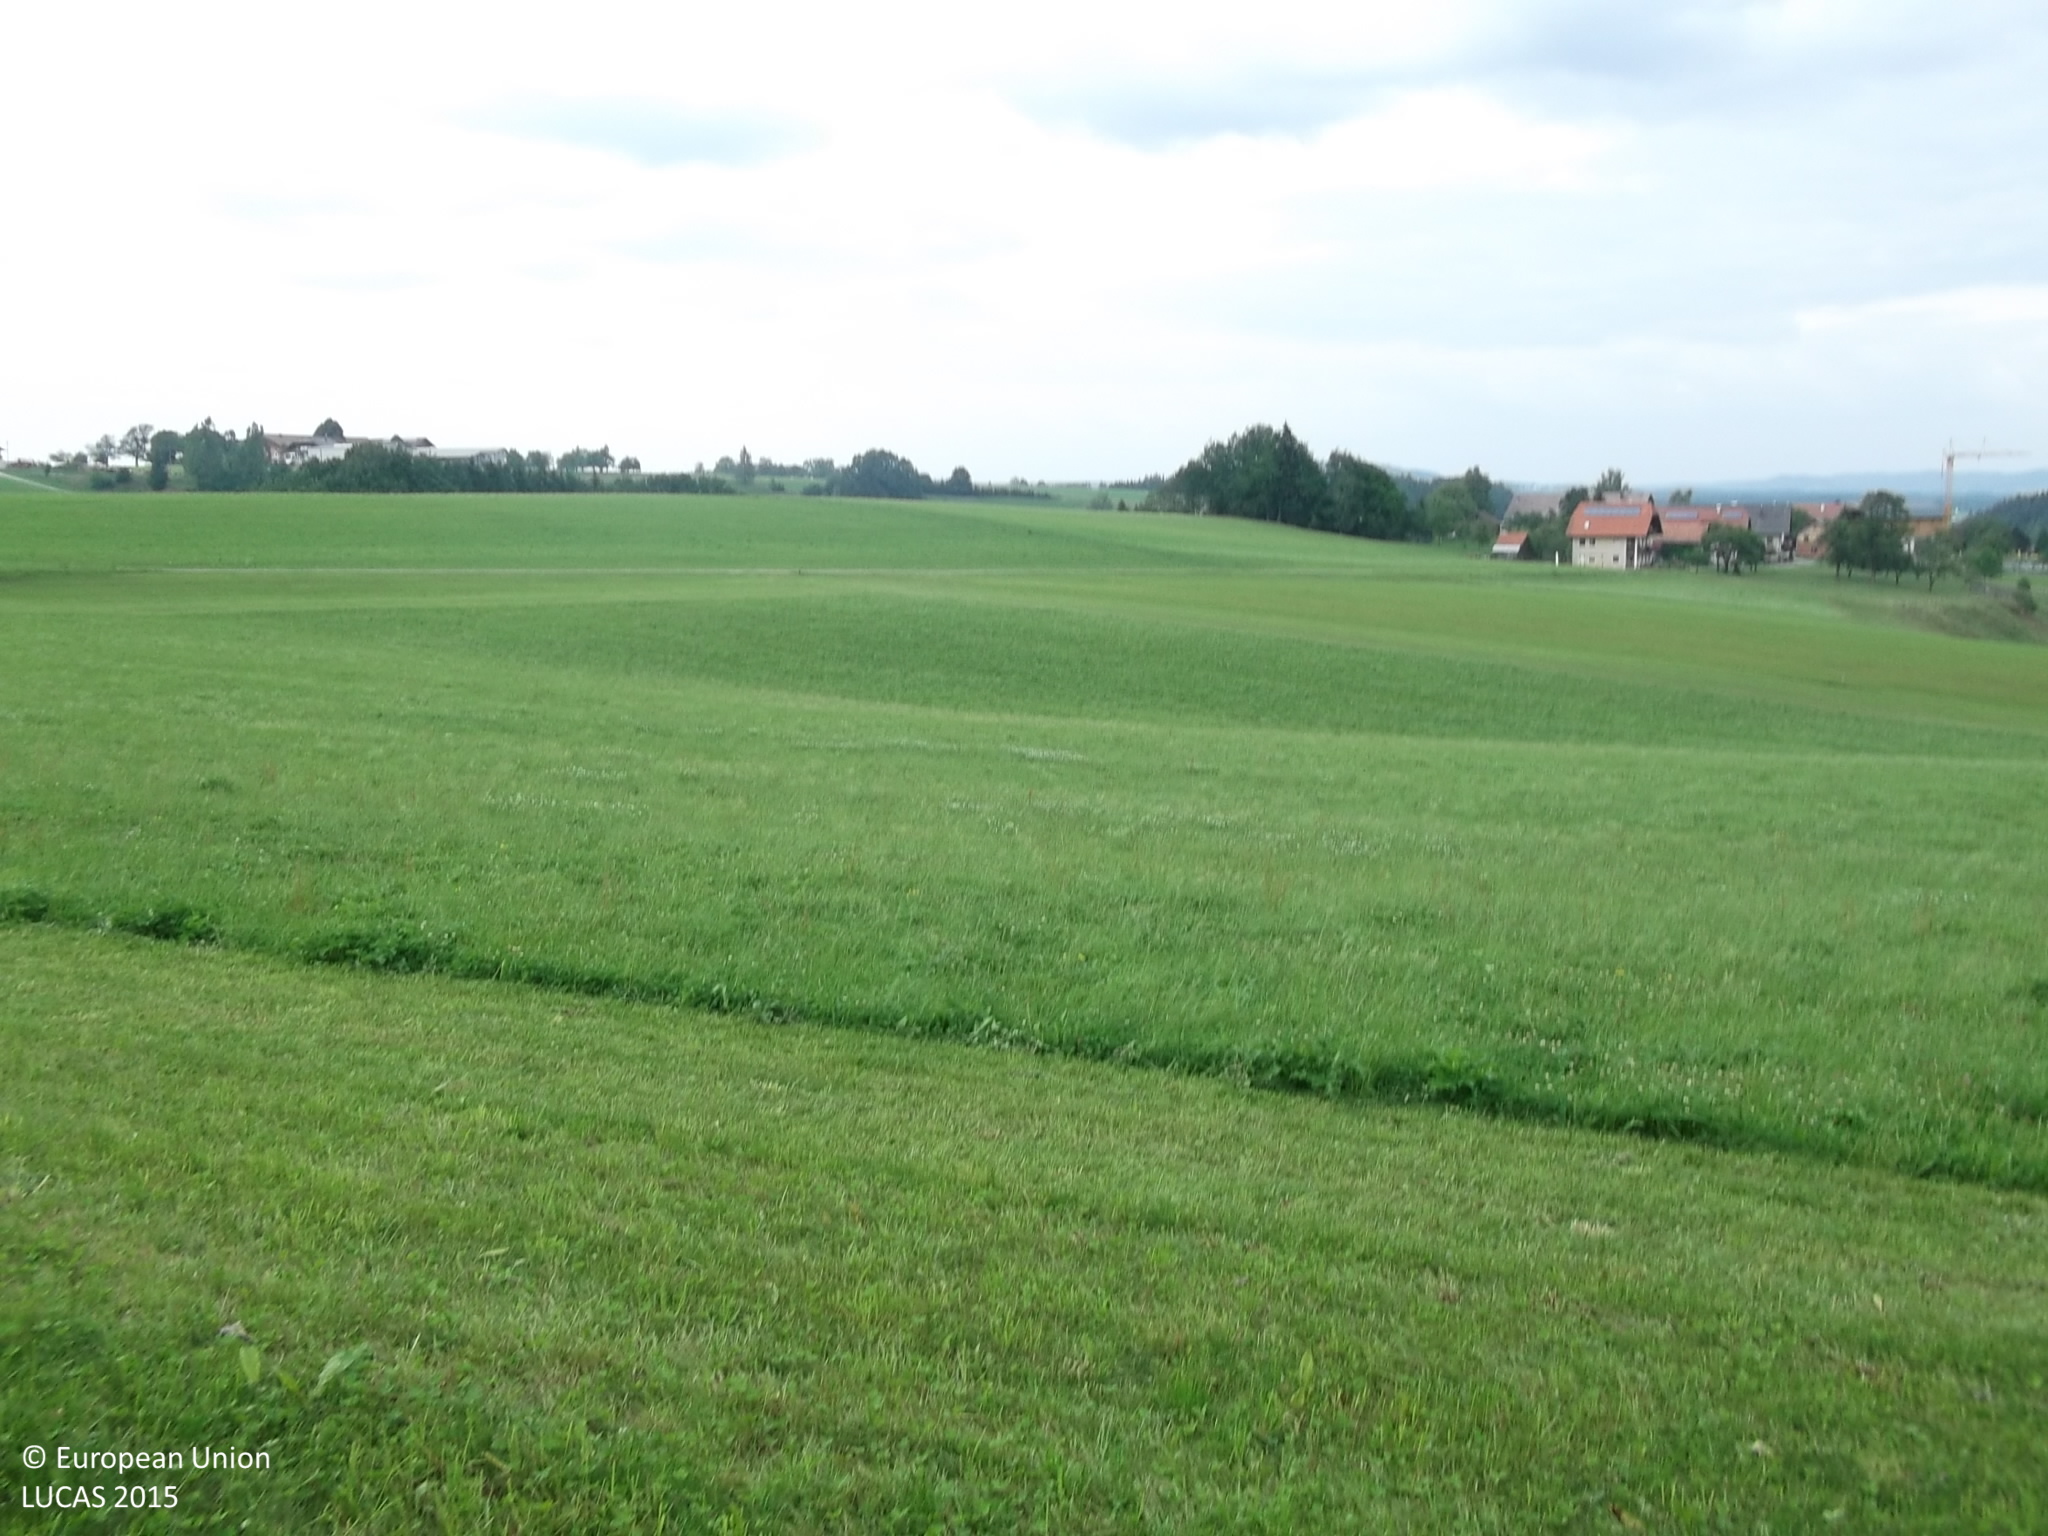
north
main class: Grassland
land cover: Grassland without tree/shrub cover
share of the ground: > 75 %
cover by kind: herbaceous plants 95 %, shrubs 5 %
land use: Agriculture (excluding fallow land and kitchen gardens)
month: August
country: AT
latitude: 47.9554
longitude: 13.3869
